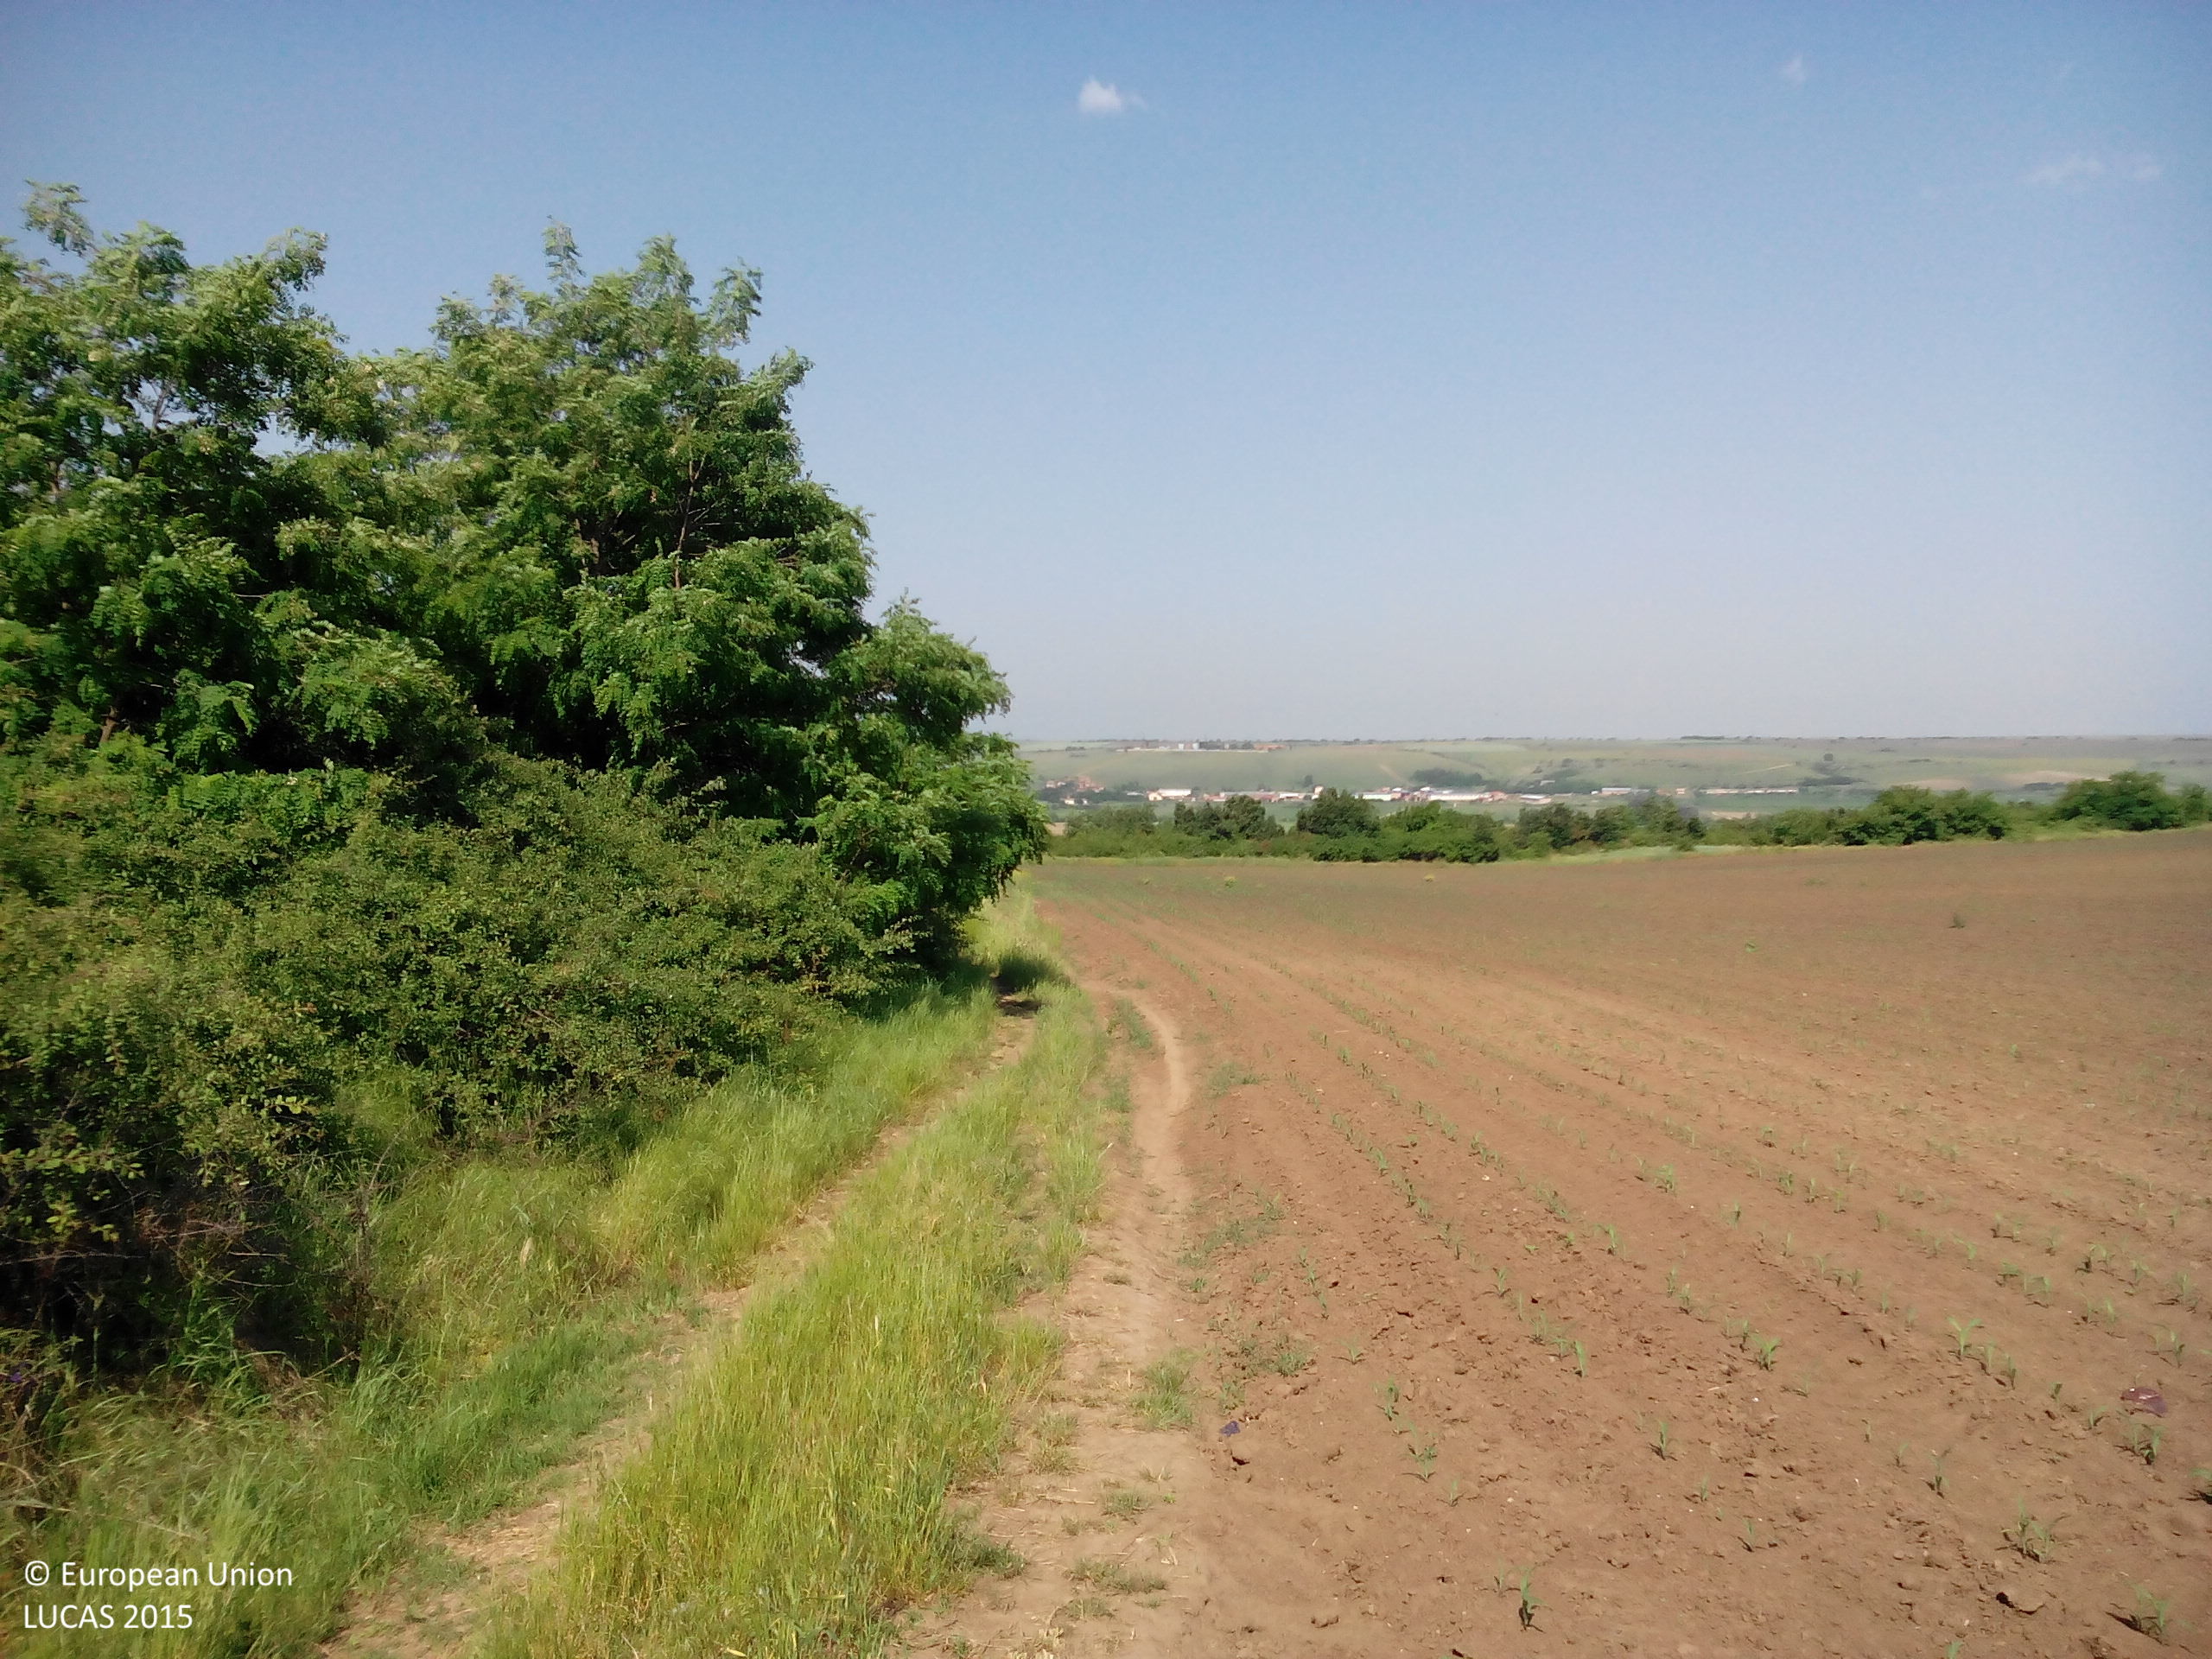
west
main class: Woodland
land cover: Broadleaved woodland
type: thermophilous deciduous forest
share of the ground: > 75 %
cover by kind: broadleaved forest trees 90 %, shrubs 5 %, herbaceous plants 5 %
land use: Forestry
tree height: < 5 m
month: May
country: BG
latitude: 43.5260
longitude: 24.2489
